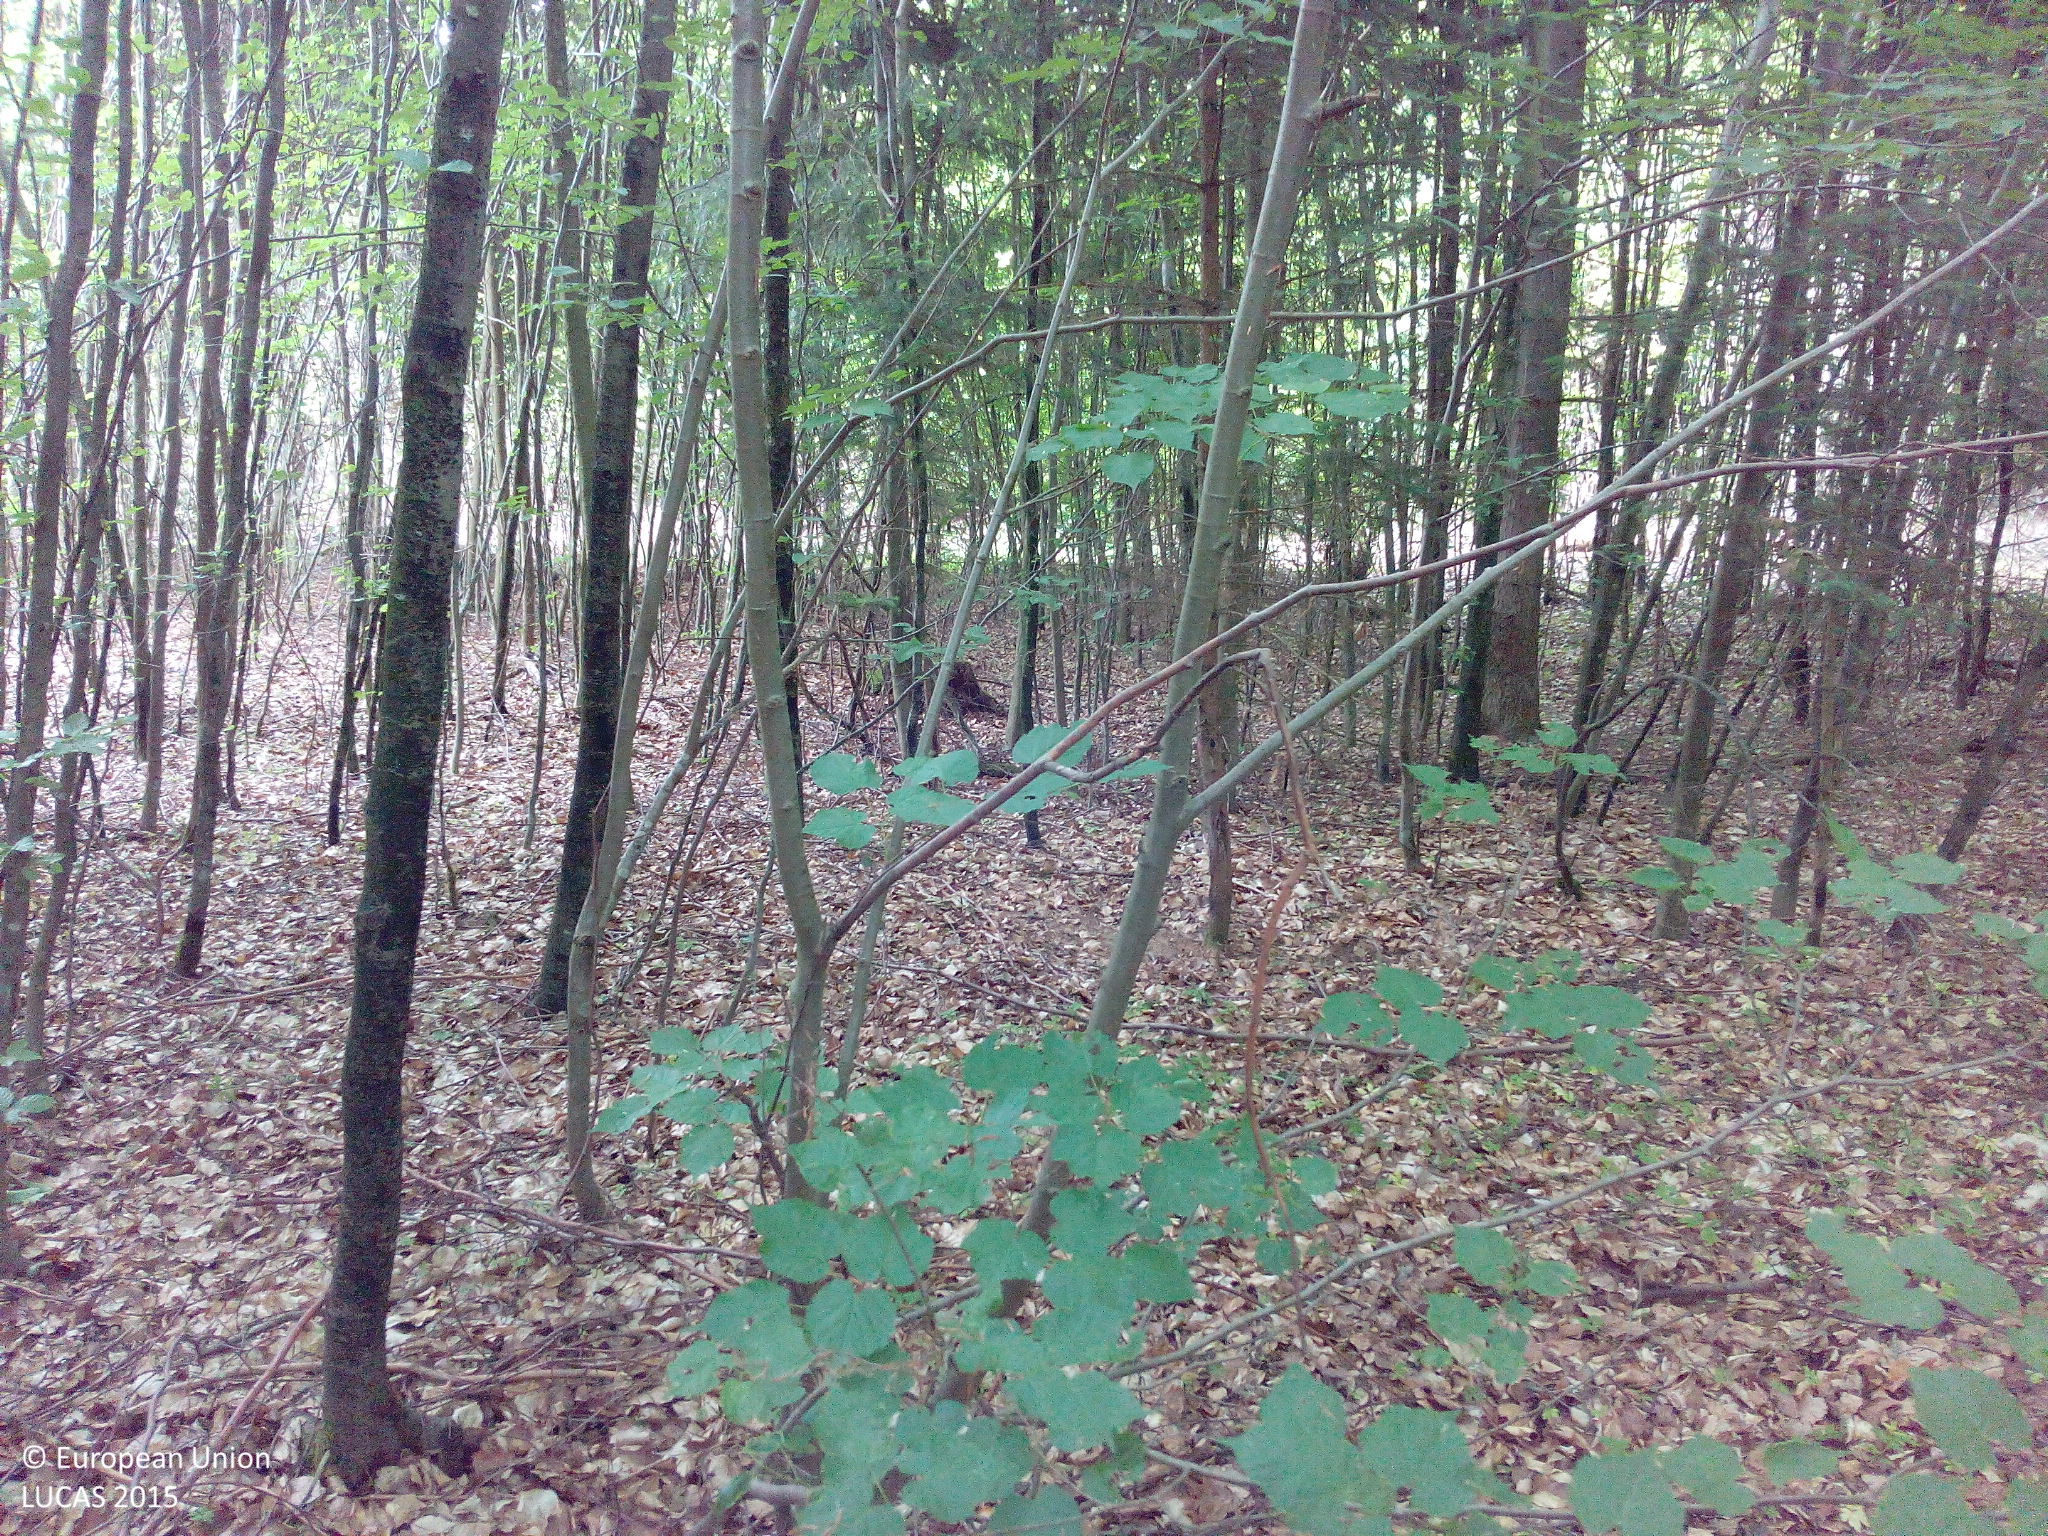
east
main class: Woodland
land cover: Broadleaved woodland
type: mesophytic deciduous forest
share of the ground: > 75 %
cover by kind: broadleaved forest trees 90 %, coniferous forest trees 10 %
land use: Forestry
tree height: > 5 m
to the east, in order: Broadleaved woodland; Tracks; Other mixed woodland; Broadleaved woodland; Pine dominated mixed woodland
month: June
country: DE
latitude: 50.2738
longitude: 10.2665
